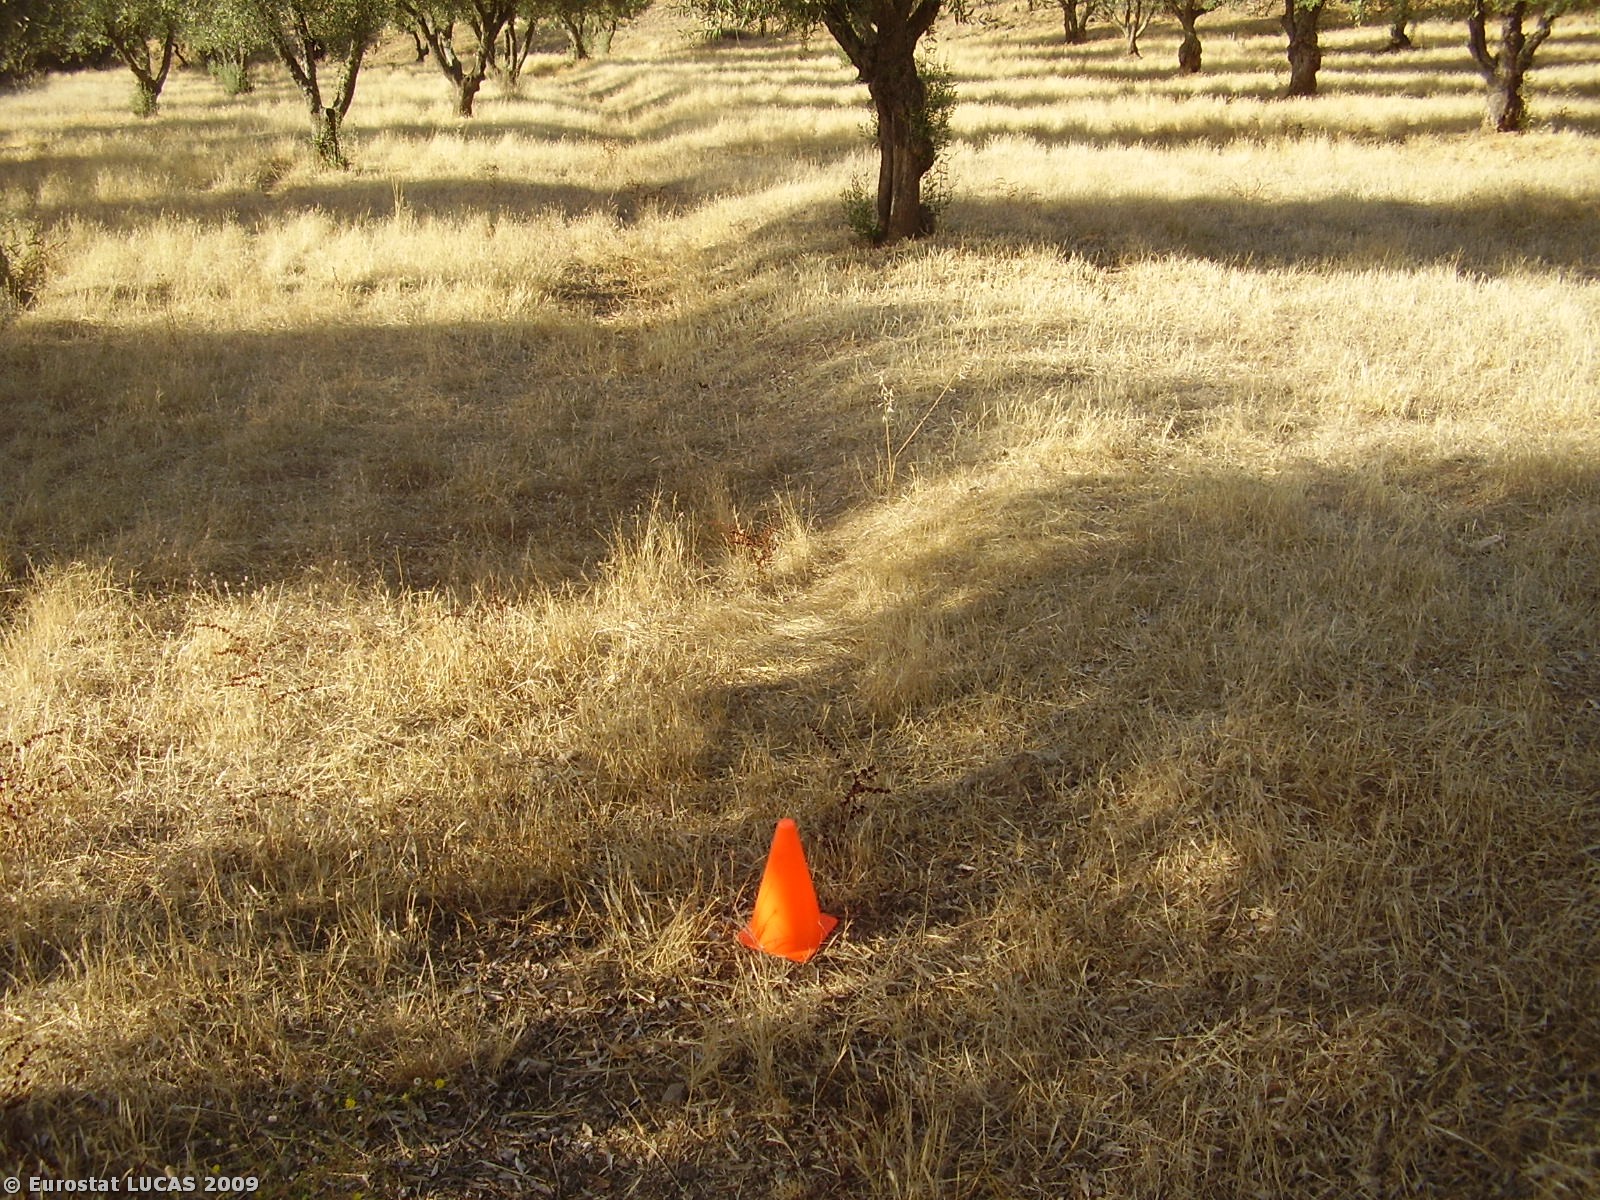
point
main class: Cropland
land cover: Olive groves
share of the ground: 25 - 50 %
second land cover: Spontaneously vegetated surfaces
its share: 50 - 75 %
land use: Agriculture (excluding fallow land and kitchen gardens)
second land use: Fallow land
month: July
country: PT
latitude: 37.7454
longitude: -7.7580
